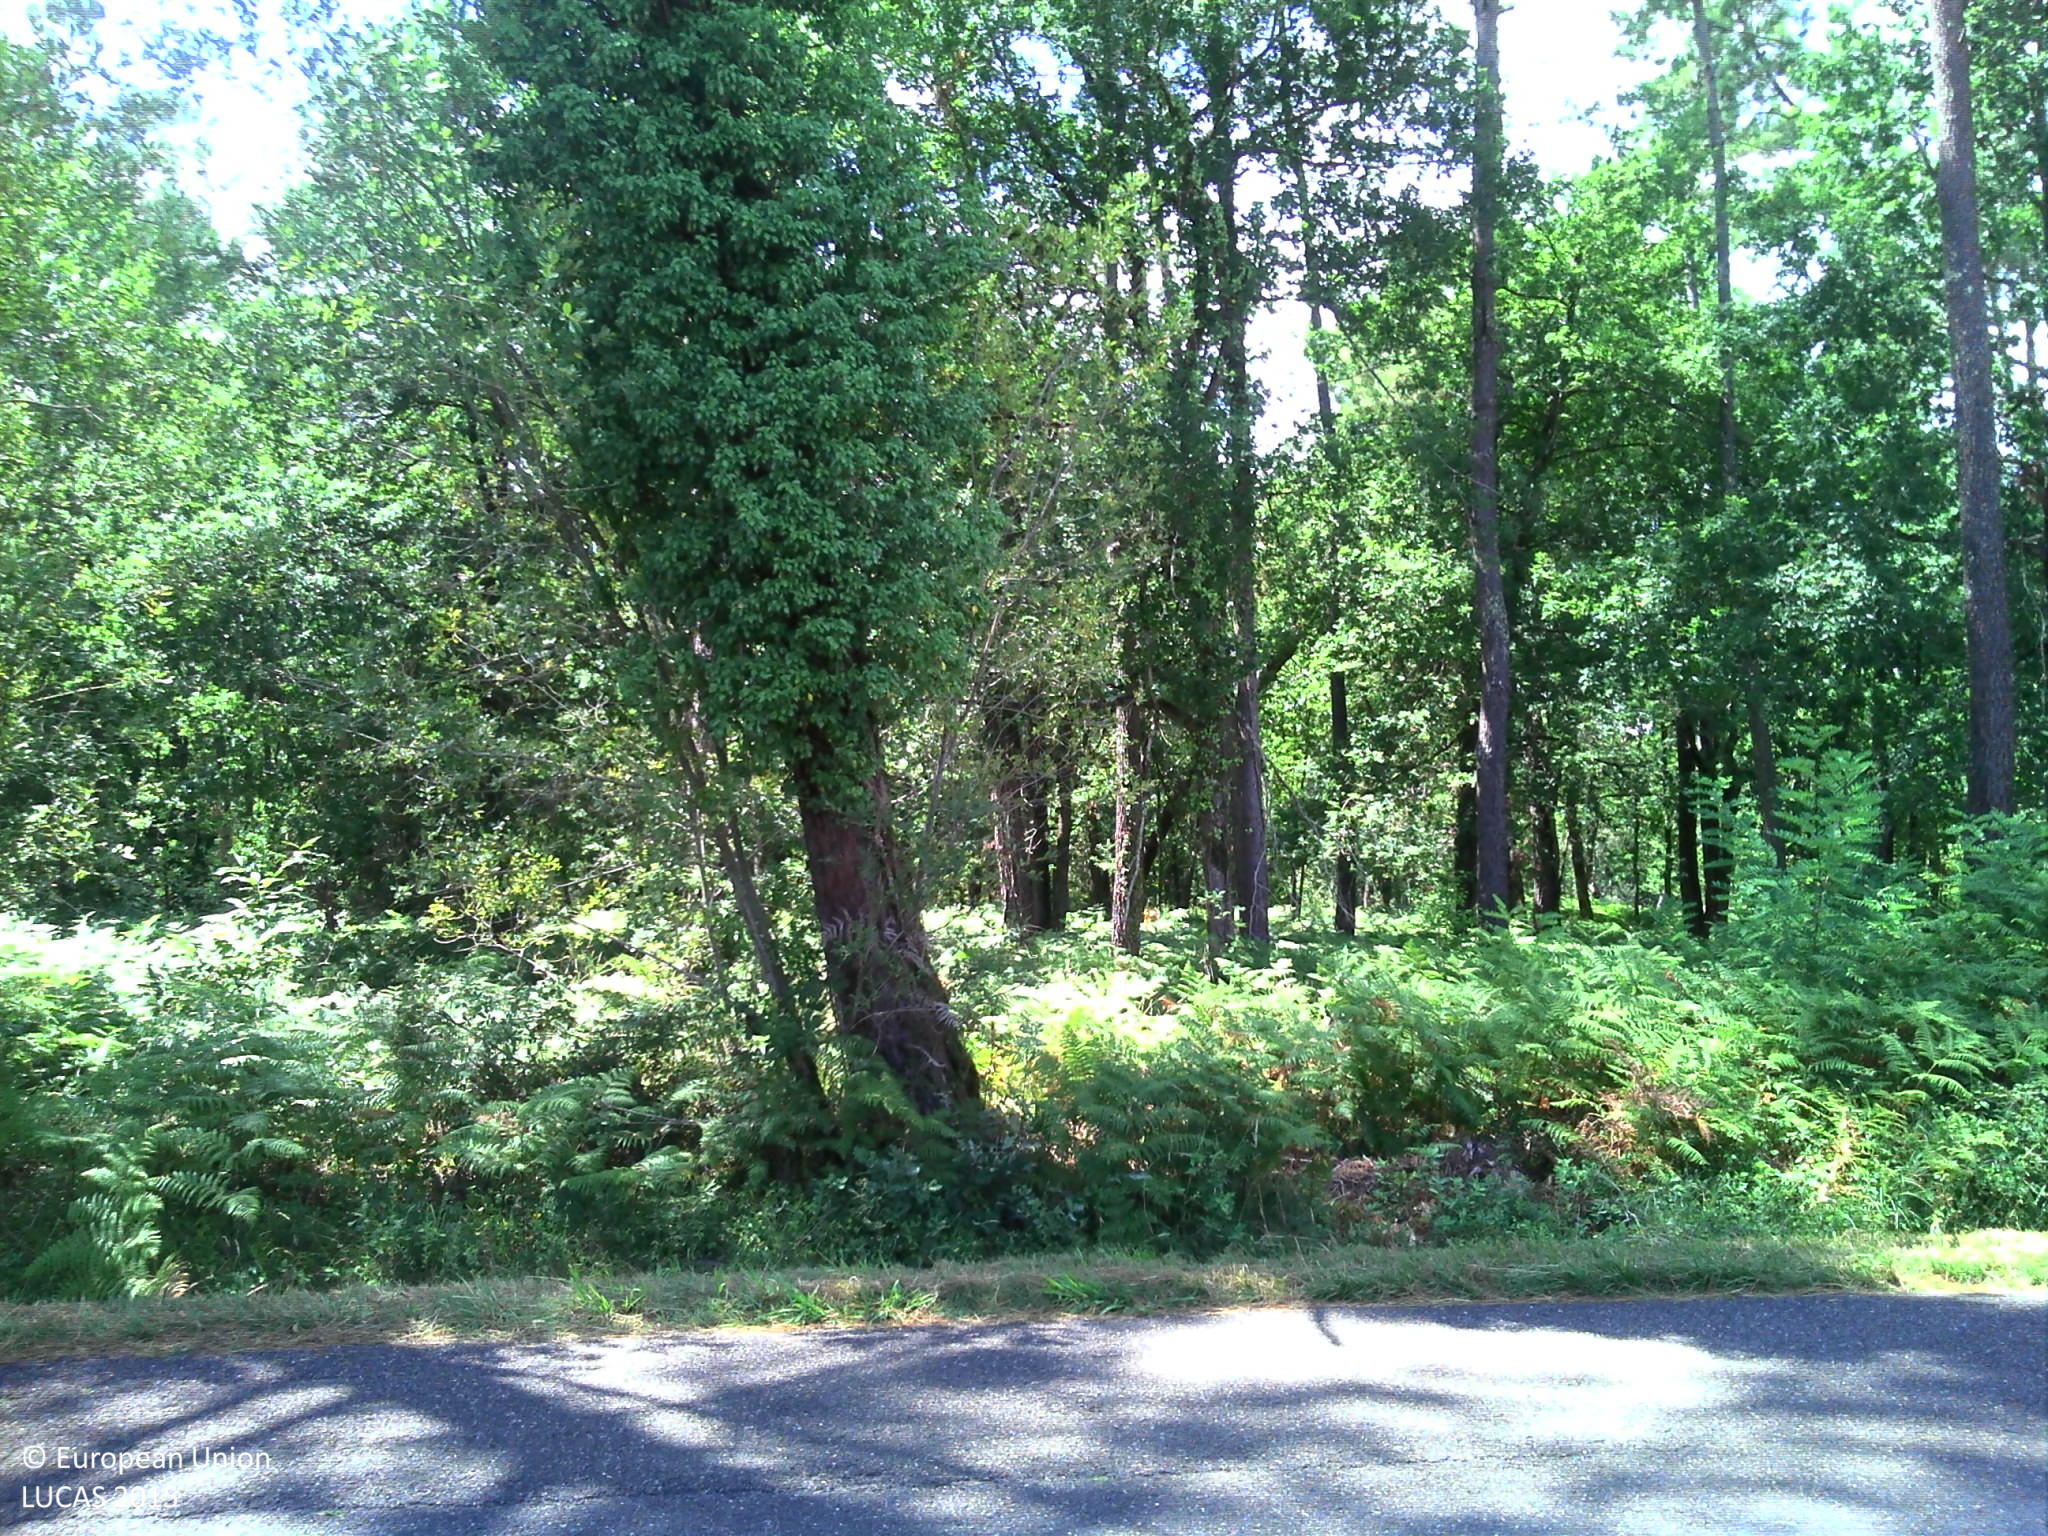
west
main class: Grassland
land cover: Grassland without tree/shrub cover
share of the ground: > 75 %
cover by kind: herbaceous plants 100 %
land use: Agriculture (excluding fallow land and kitchen gardens)
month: July
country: FR
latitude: 43.8682
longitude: -0.5266
